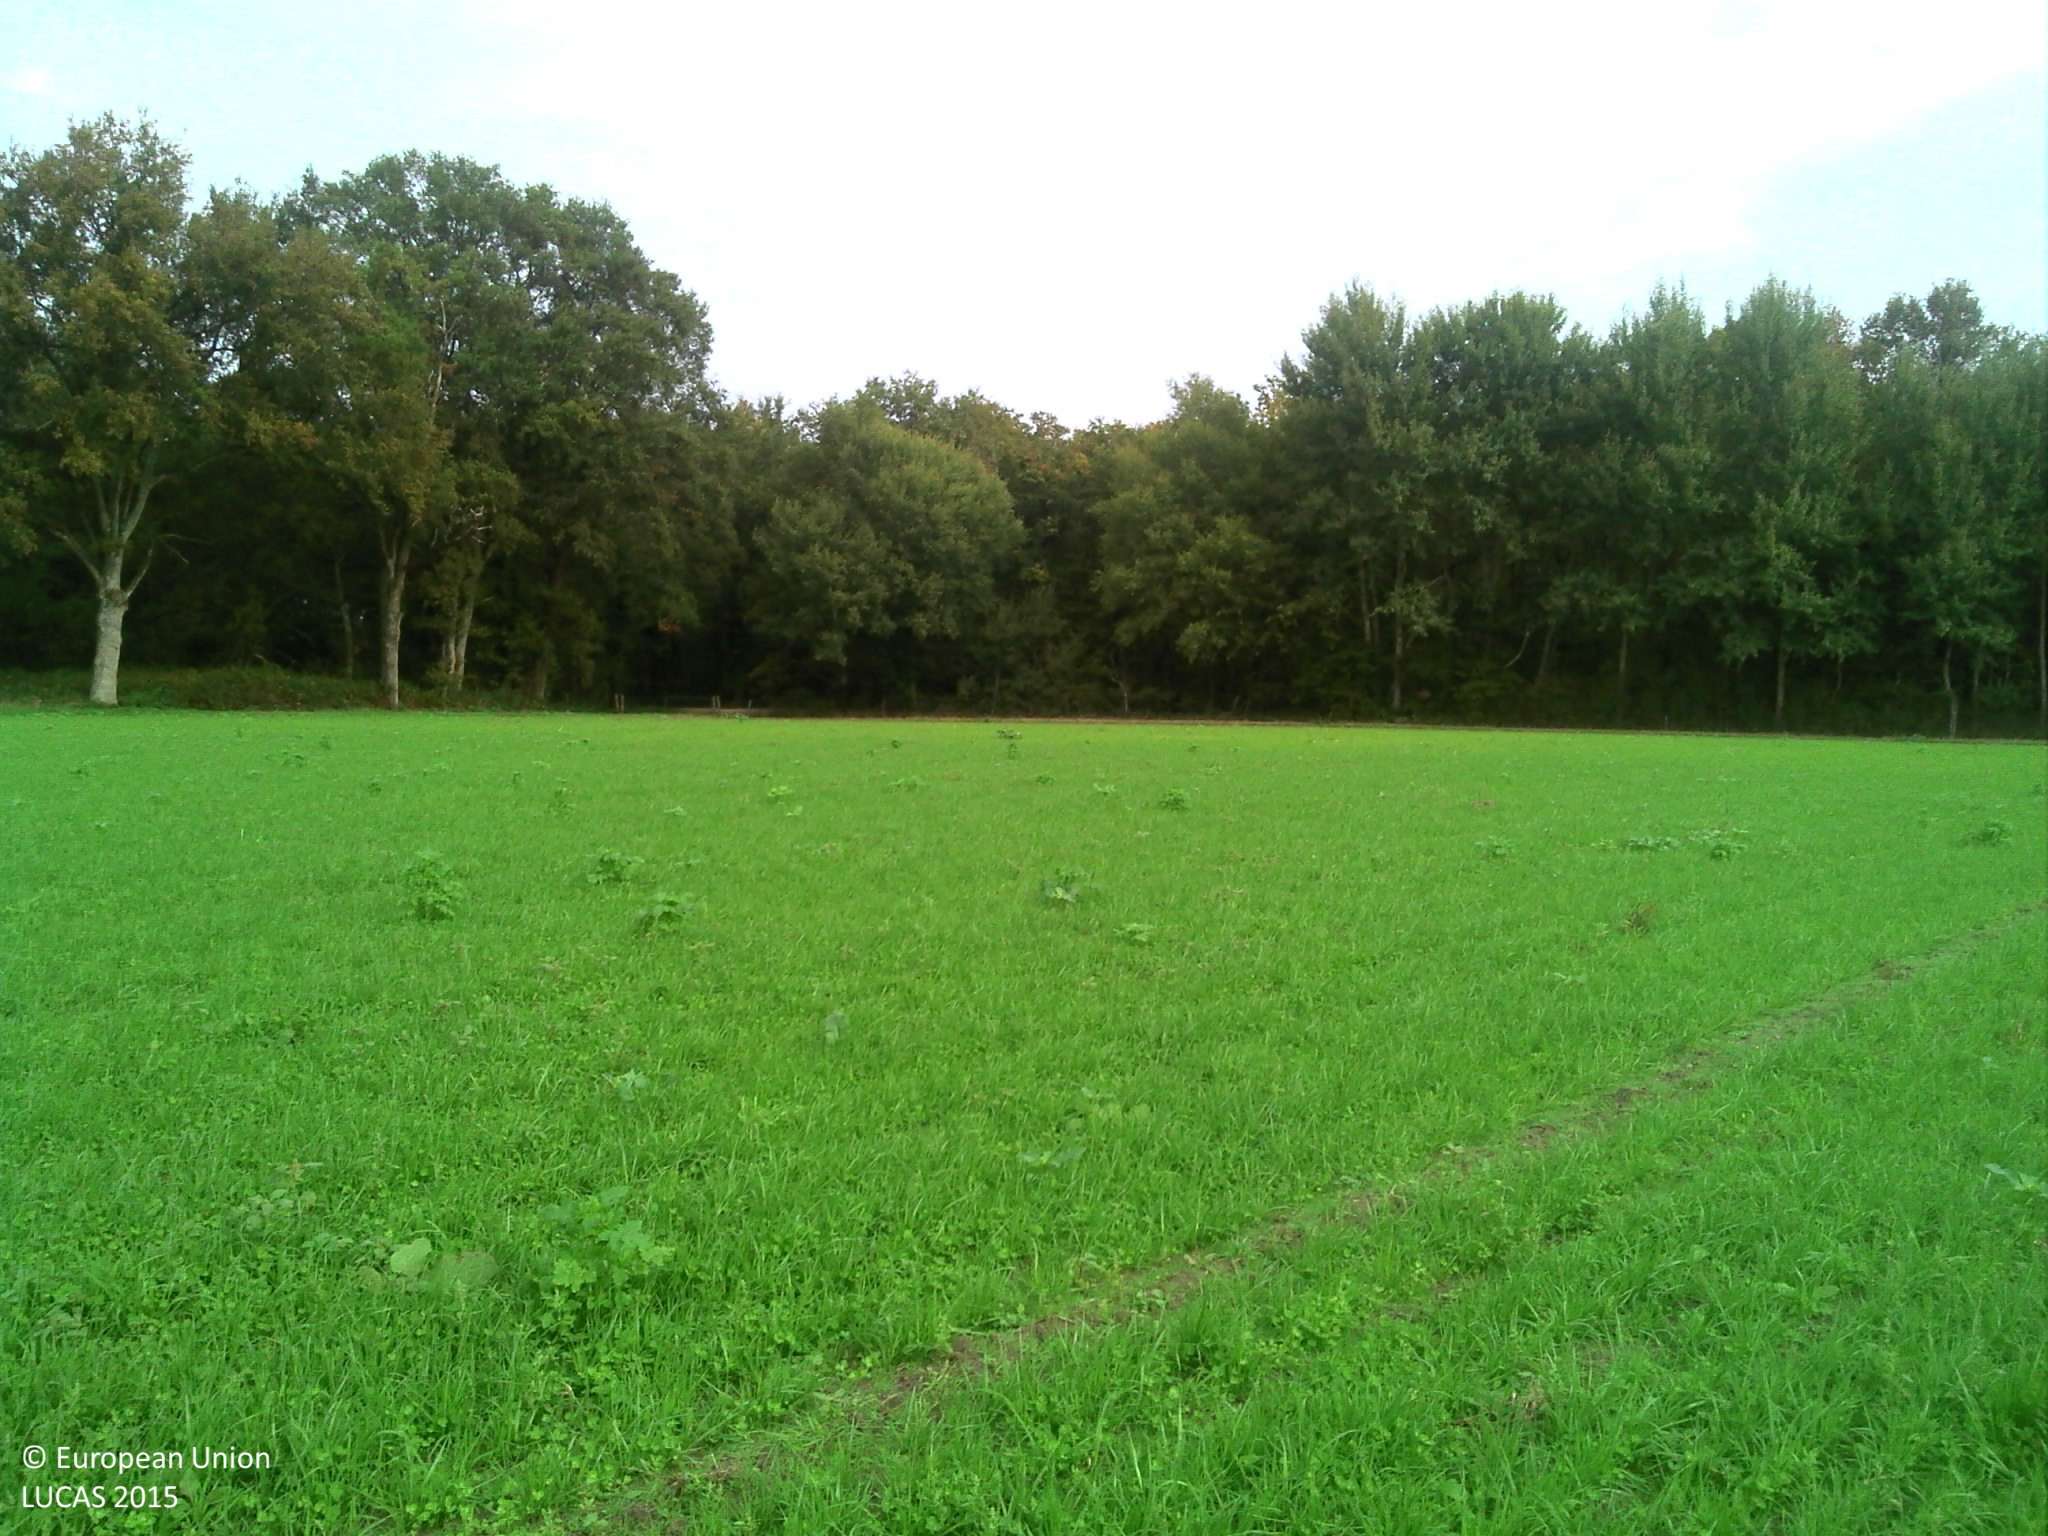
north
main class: Cropland
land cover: Temporary grasslands
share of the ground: > 75 %
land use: Agriculture (excluding fallow land and kitchen gardens)
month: October
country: FR
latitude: 47.5607
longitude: 2.1084
